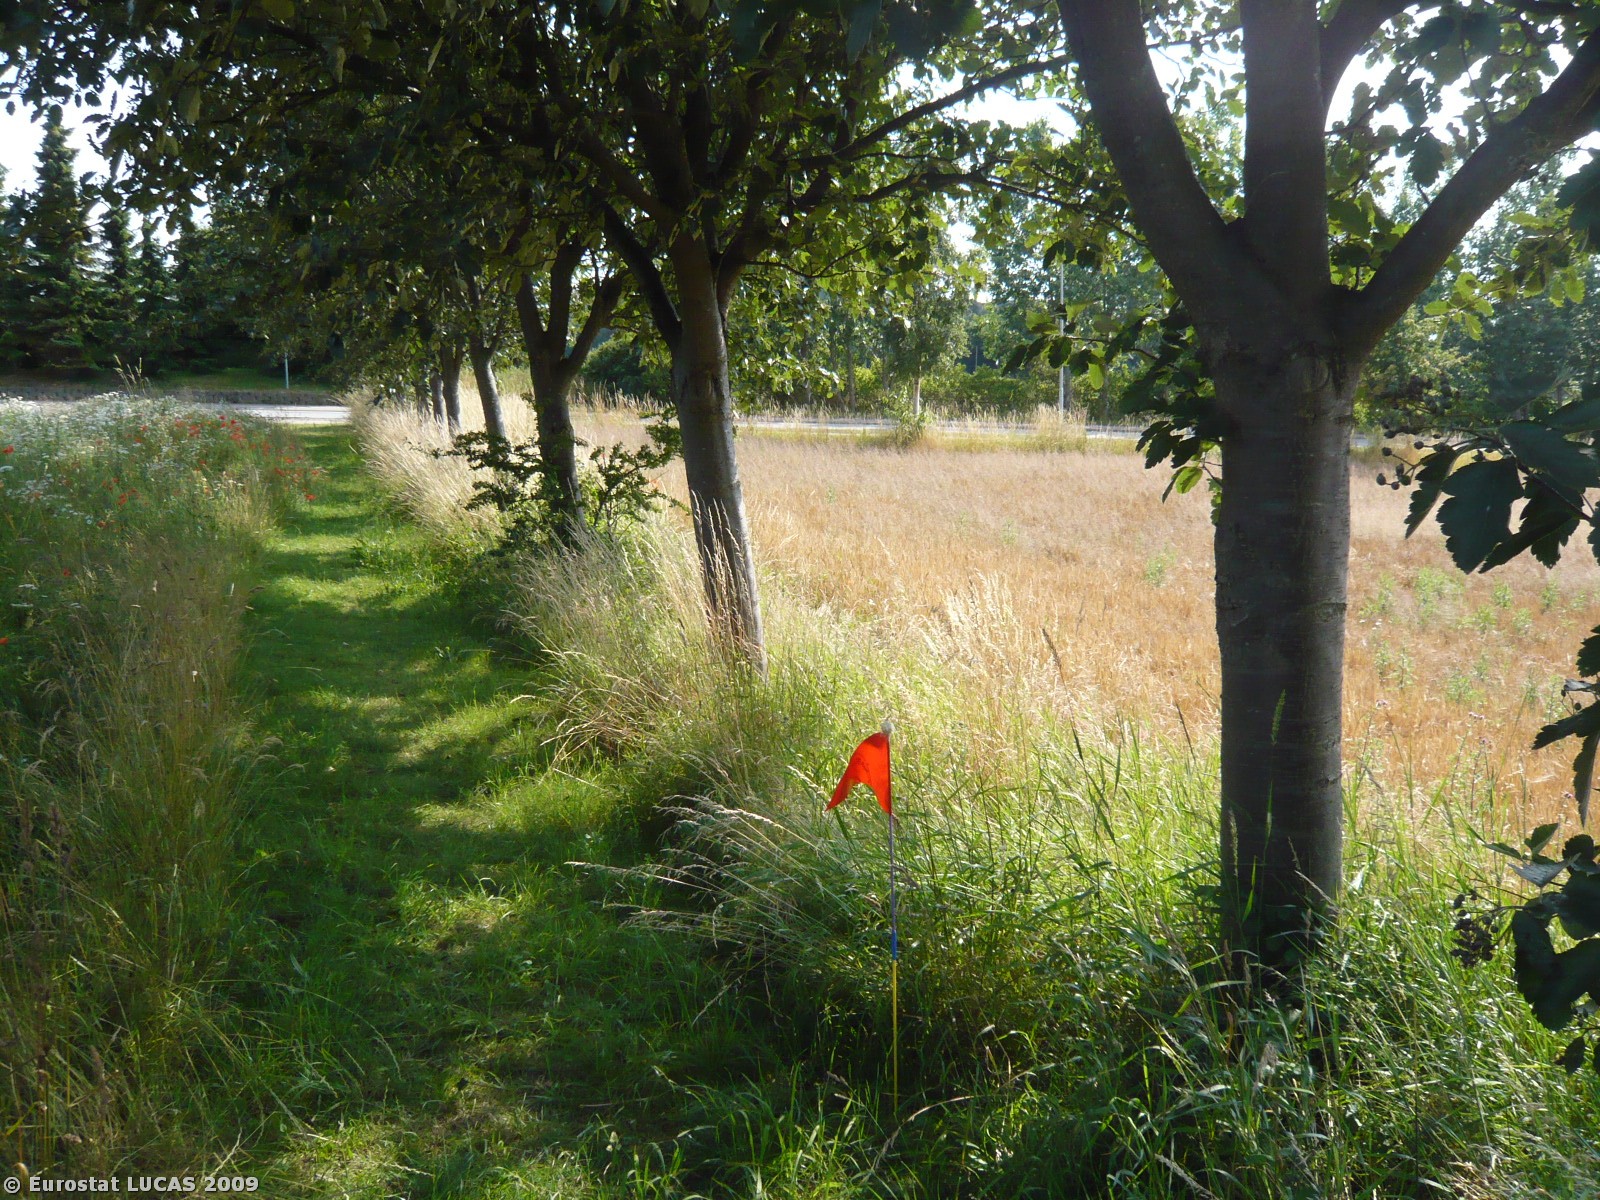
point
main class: Woodland
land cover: Broadleaved woodland
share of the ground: > 75 %
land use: Sport
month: July
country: DK
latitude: 55.9079
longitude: 11.6140
